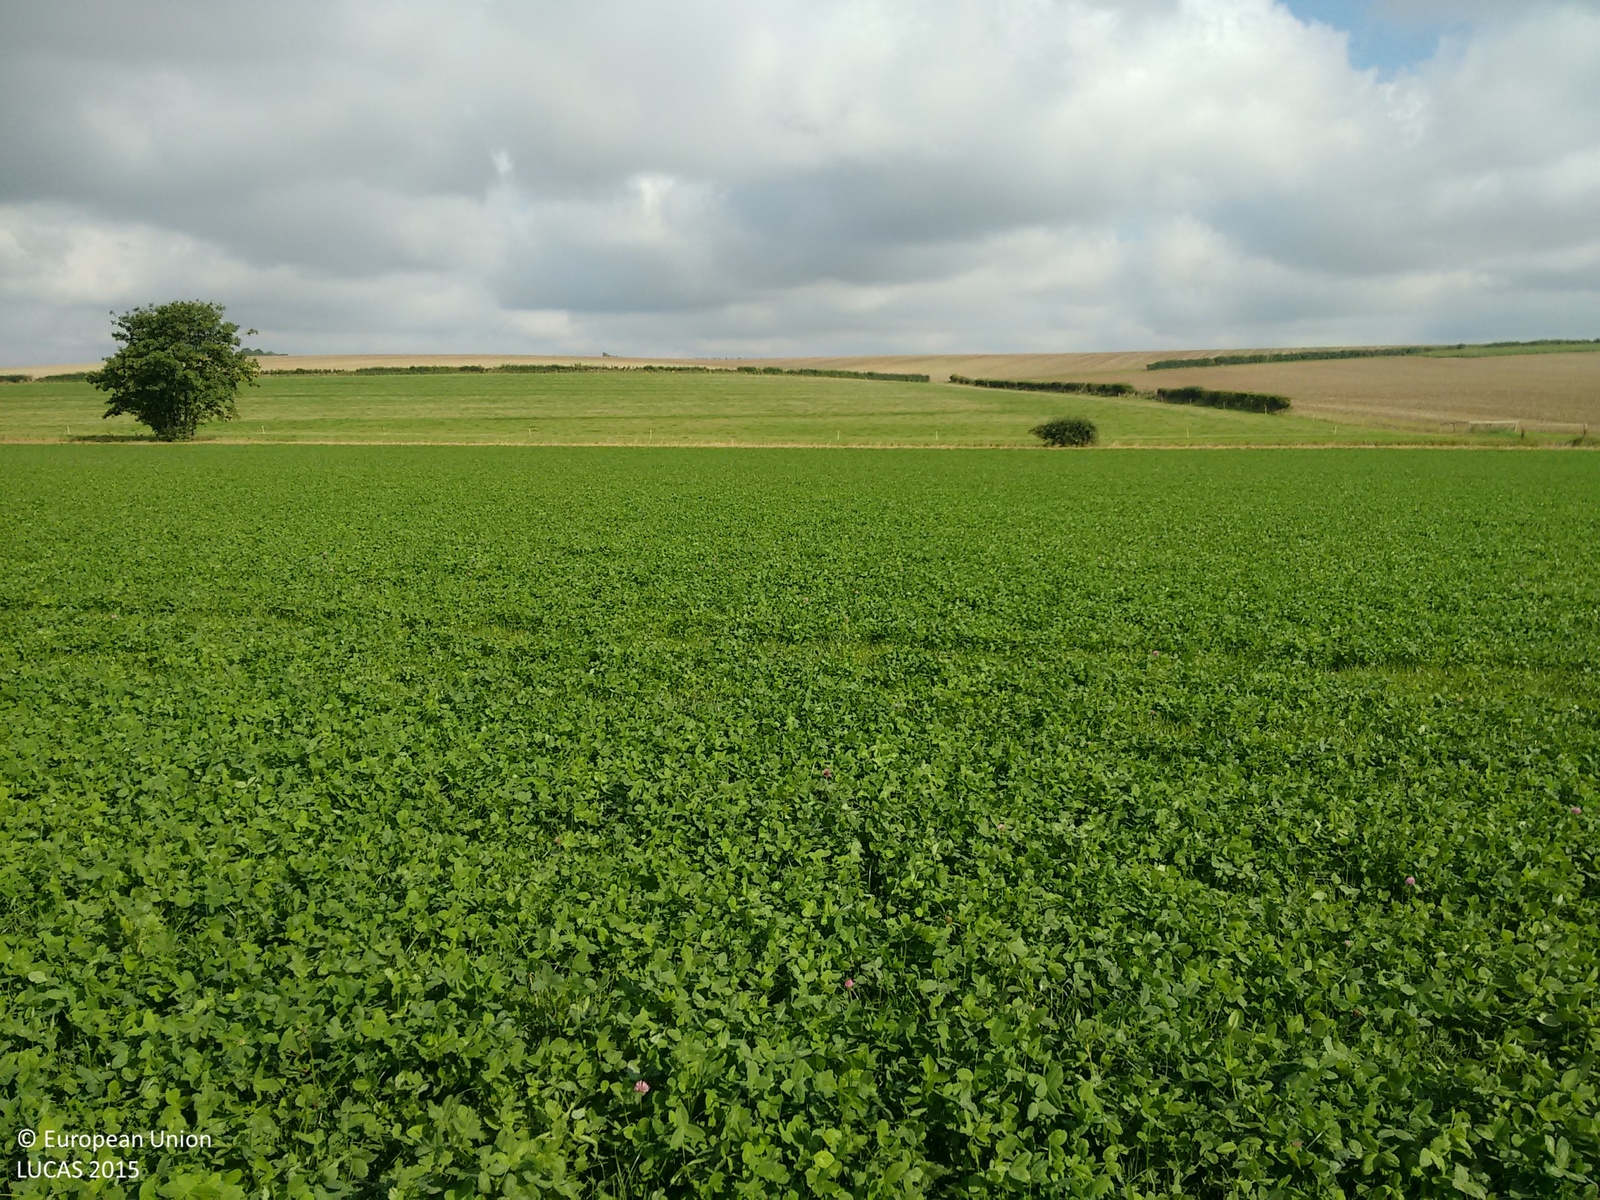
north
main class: Cropland
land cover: Clovers
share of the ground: > 75 %
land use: Agriculture (excluding fallow land and kitchen gardens)
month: September
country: GB
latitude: 52.2132
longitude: 0.5031
